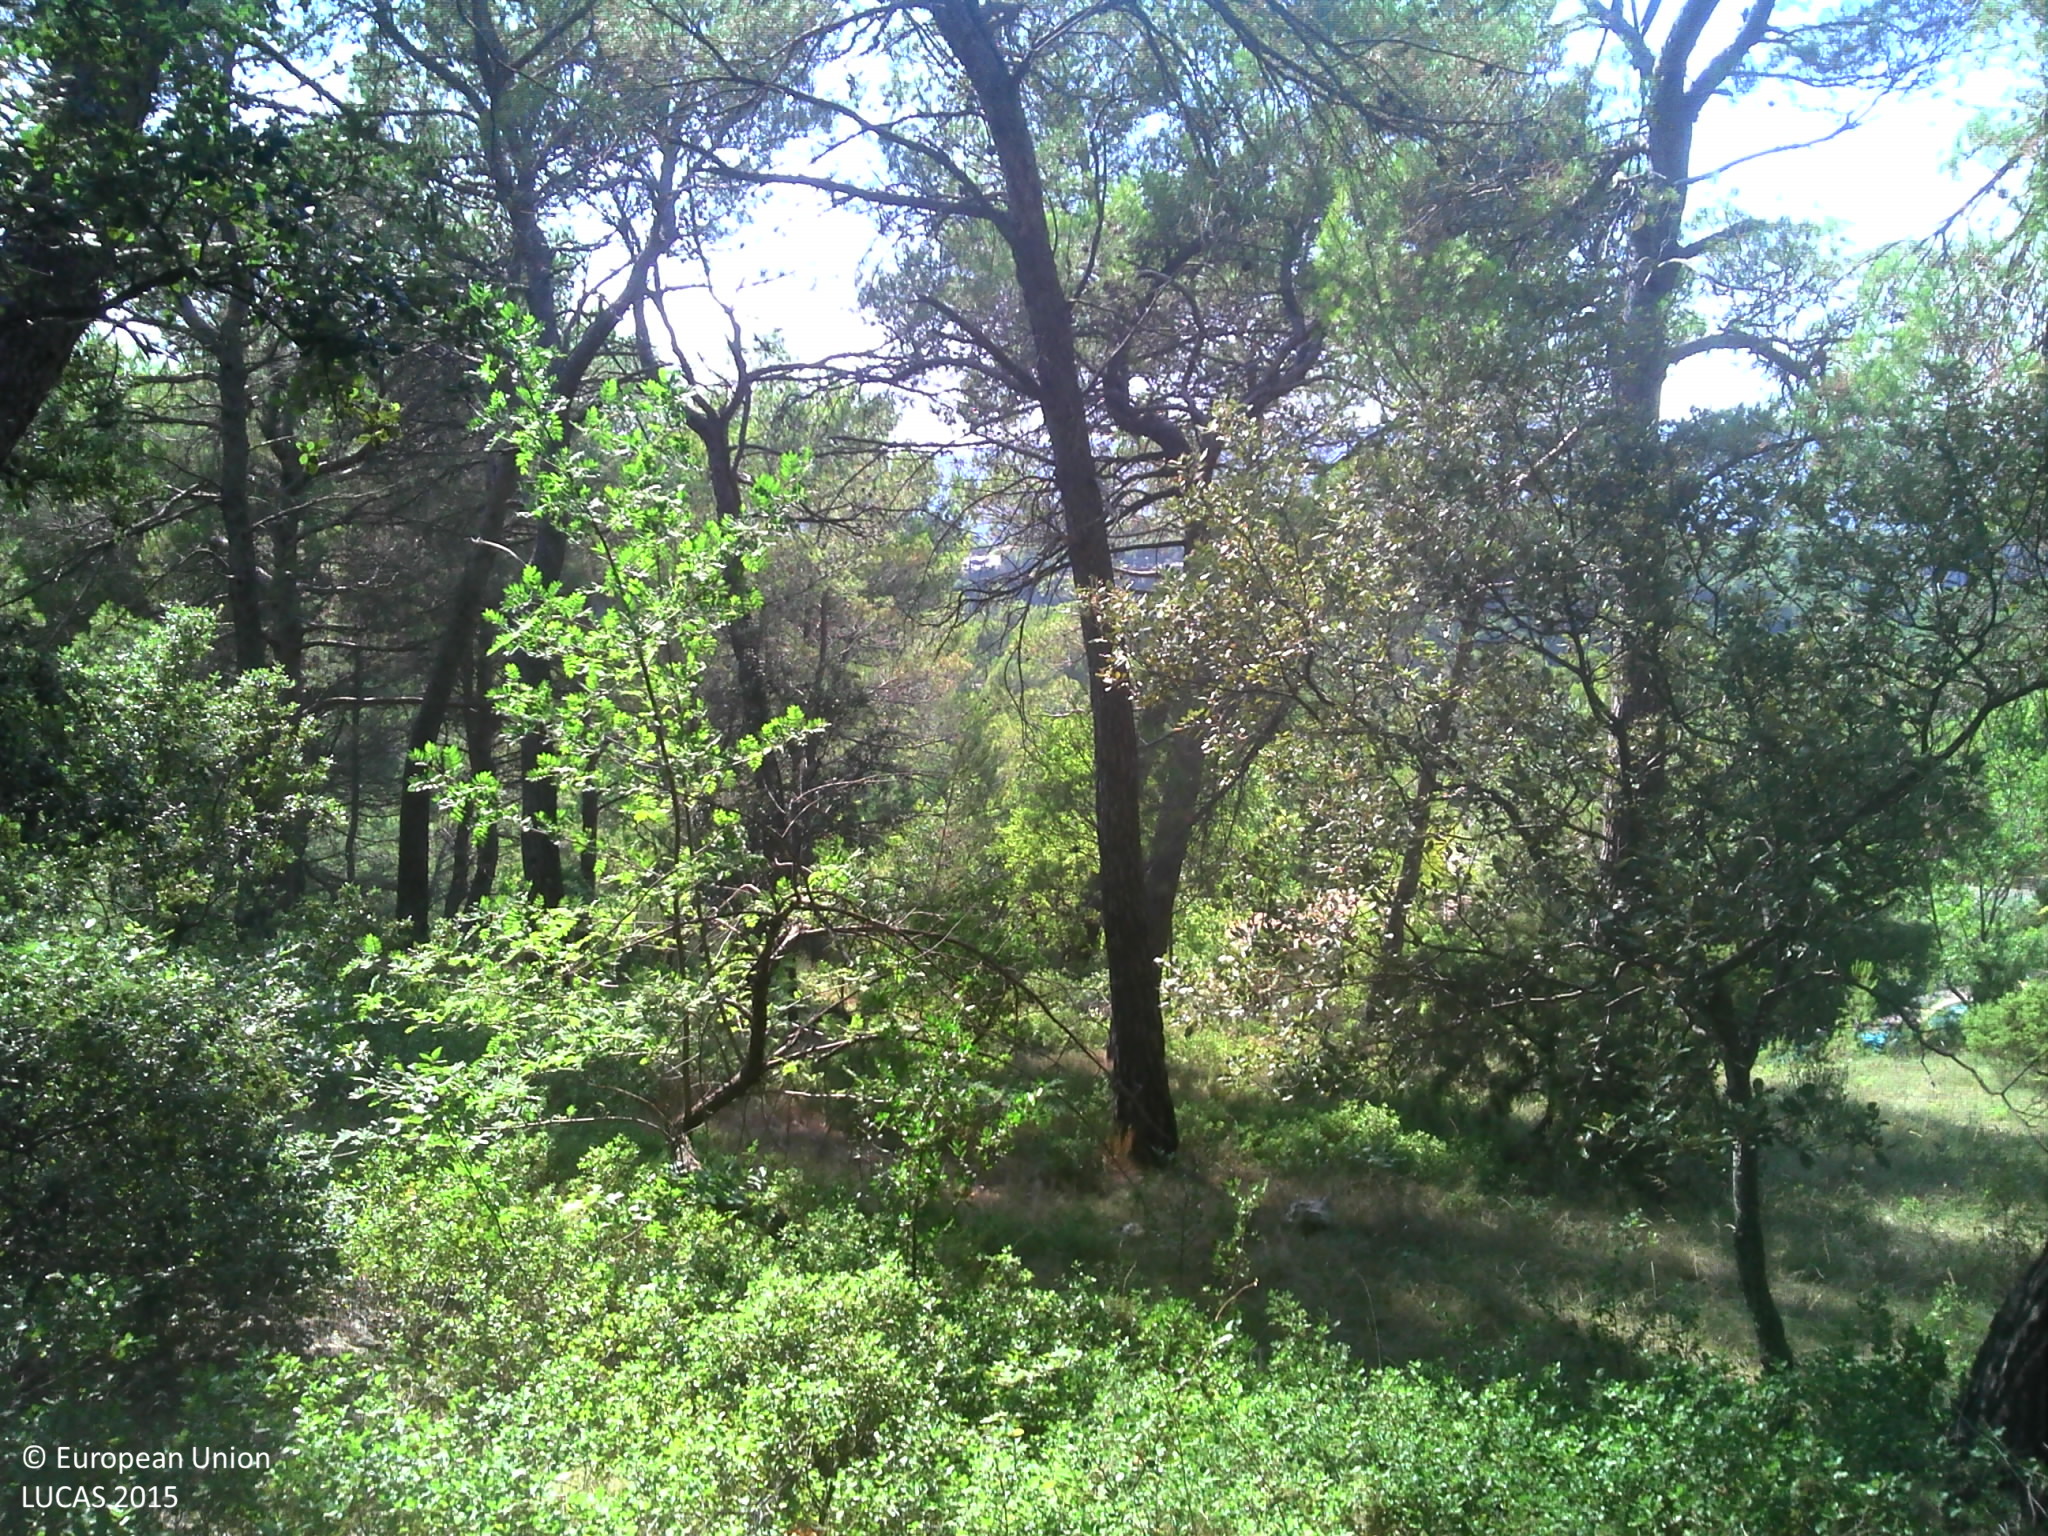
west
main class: Woodland
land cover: Pine dominated coniferous woodland
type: coniferous forest of the mediterranean region
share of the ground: > 75 %
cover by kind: coniferous forest trees 60 %, broadleaved forest trees 15 %, shrubs 10 %, herbaceous plants 10 %, consolidated bare surface 5 %
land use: Forestry
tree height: > 5 m
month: July
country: FR
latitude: 43.6686
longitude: 5.3585
